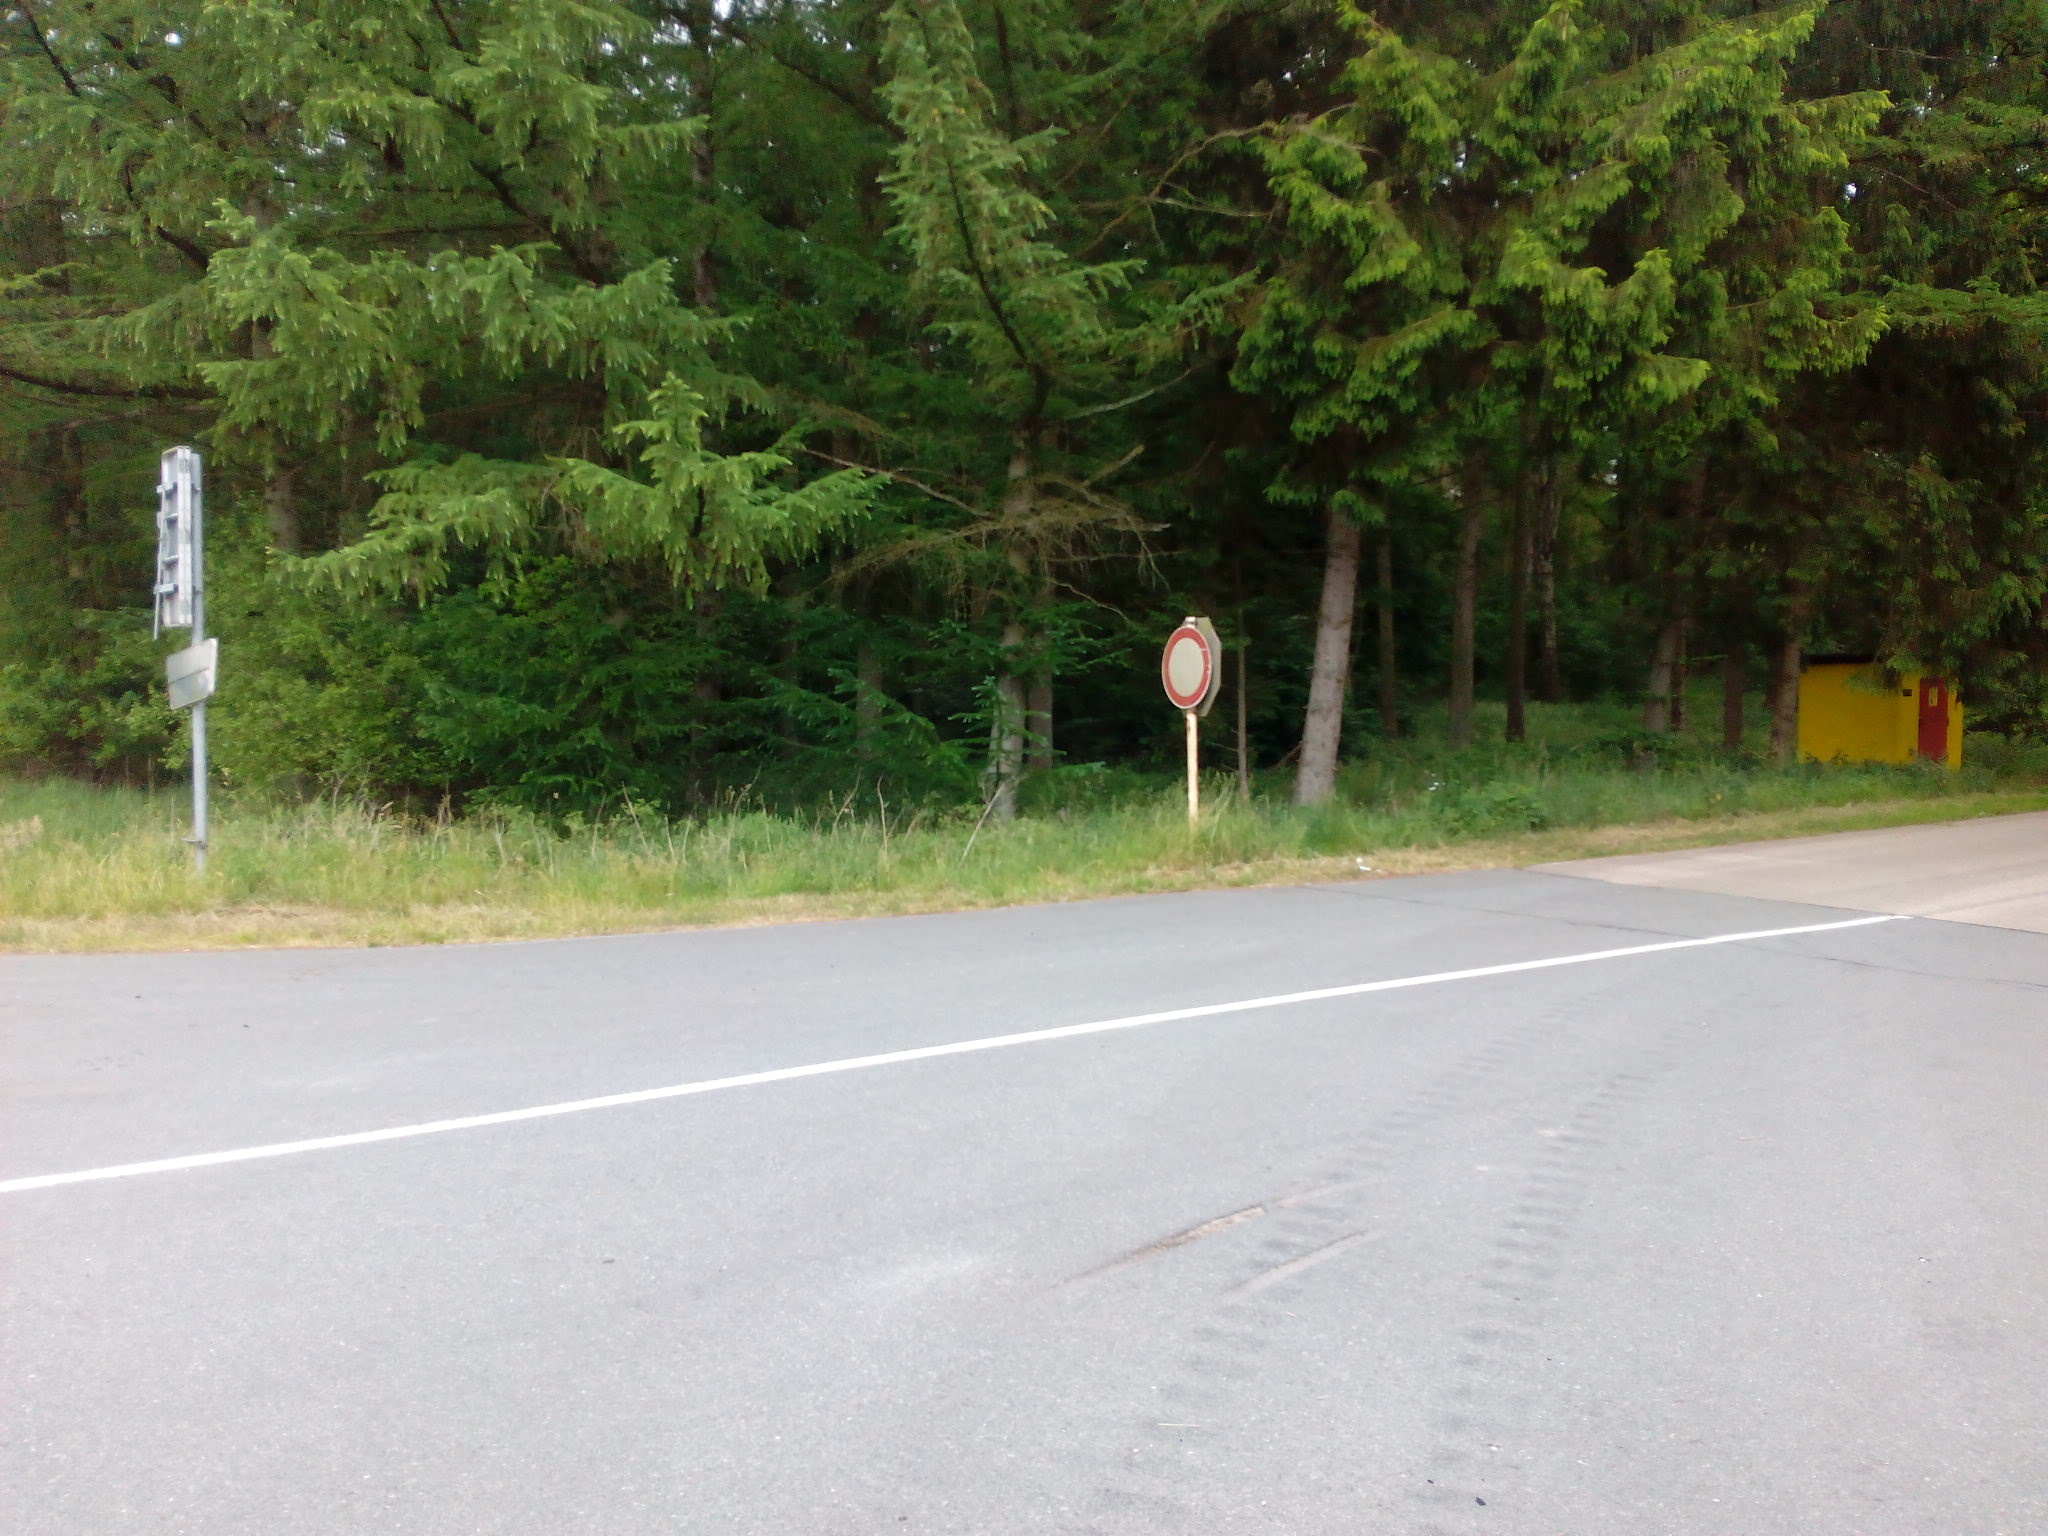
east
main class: Woodland
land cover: Pine dominated coniferous woodland
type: hemiboreal forest and nemoral coniferous forest and mixed broadleaved-coniferous forest
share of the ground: 50 - 75 %
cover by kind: coniferous forest trees 75 %, herbaceous plants 25 %
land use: Community services
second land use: Forestry
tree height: > 5 m
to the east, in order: Pine dominated coniferous woodland; Grassland without tree/shrub cover
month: June
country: DE
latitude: 52.8806
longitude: 9.8663
